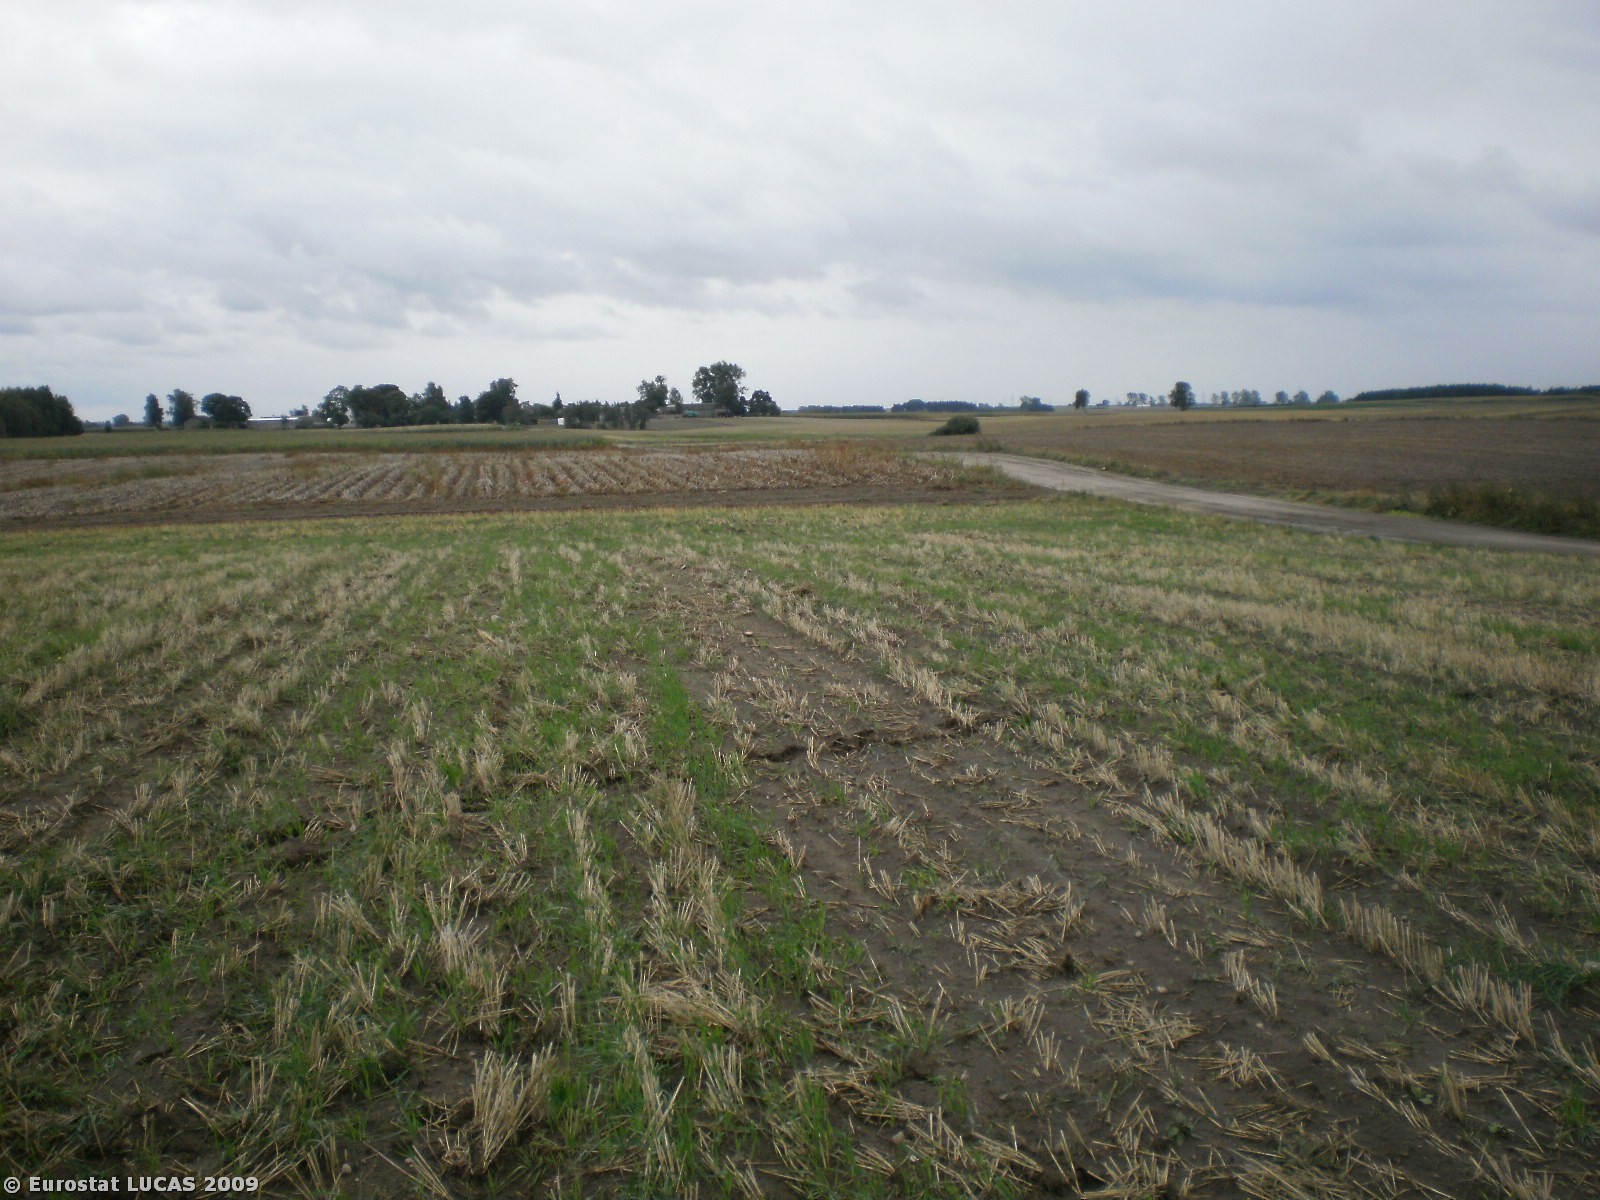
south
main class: Cropland
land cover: Triticale
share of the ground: < 10 %
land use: Agriculture (excluding fallow land and kitchen gardens)
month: September
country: PL
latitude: 53.9113
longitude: 17.7614
